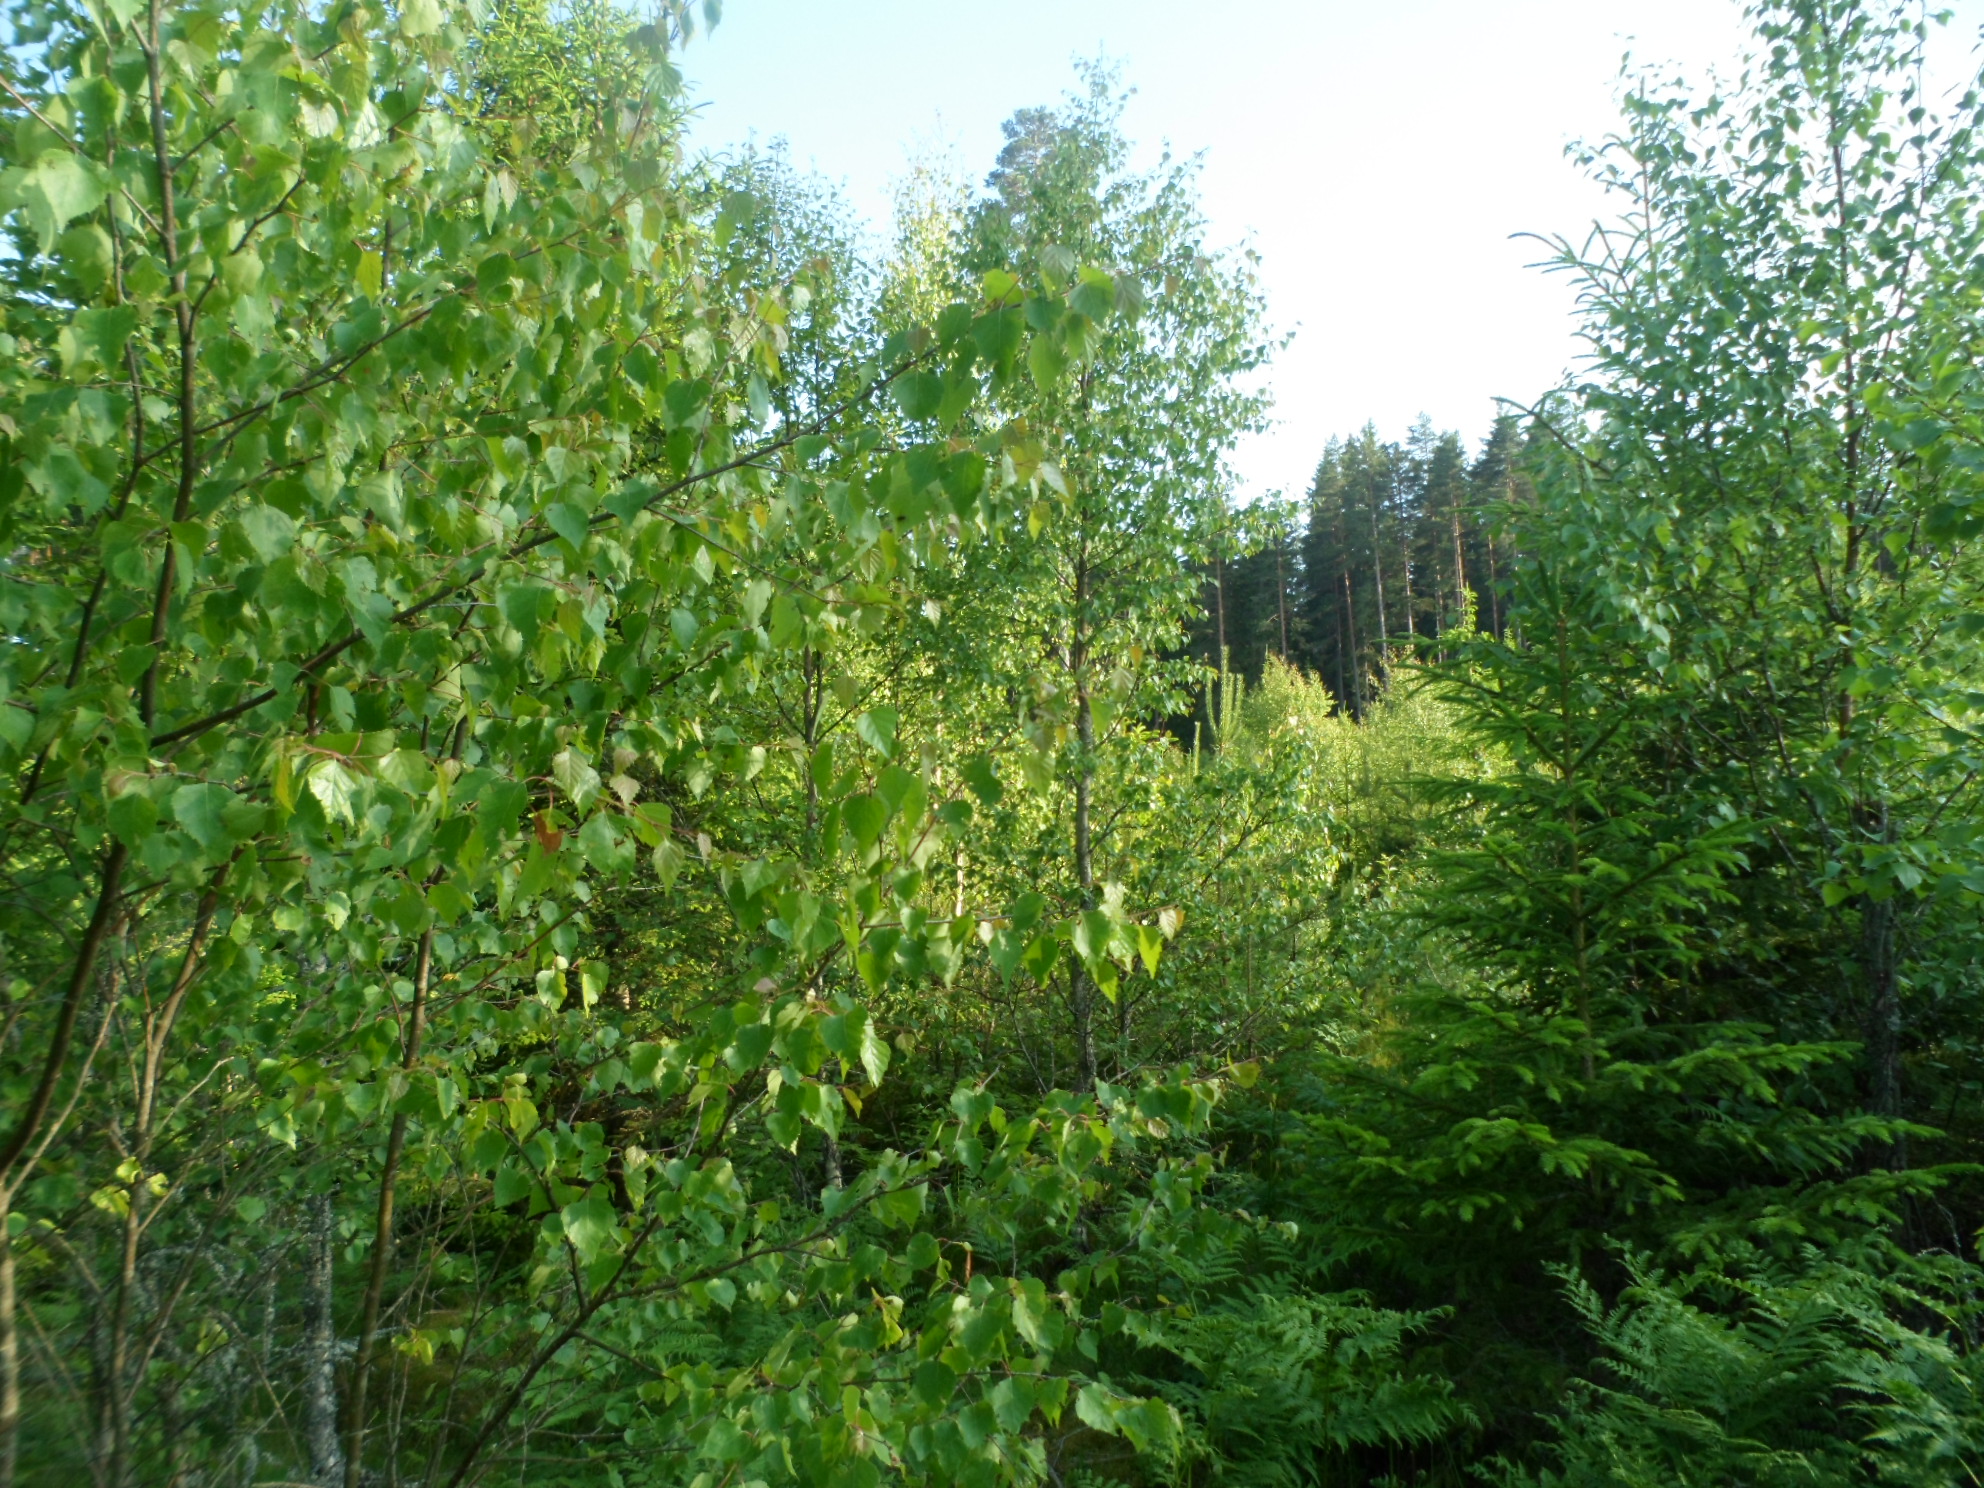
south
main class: Woodland
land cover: Spruce dominated mixed woodland
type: boreal forest
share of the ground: 50 - 75 %
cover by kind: broadleaved forest trees 35 %, coniferous forest trees 30 %, shrubs 15 %, herbaceous plants 10 %, lichens and mosses 10 %
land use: Forestry
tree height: > 5 m
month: June
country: SE
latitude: 57.0990
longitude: 15.4613
